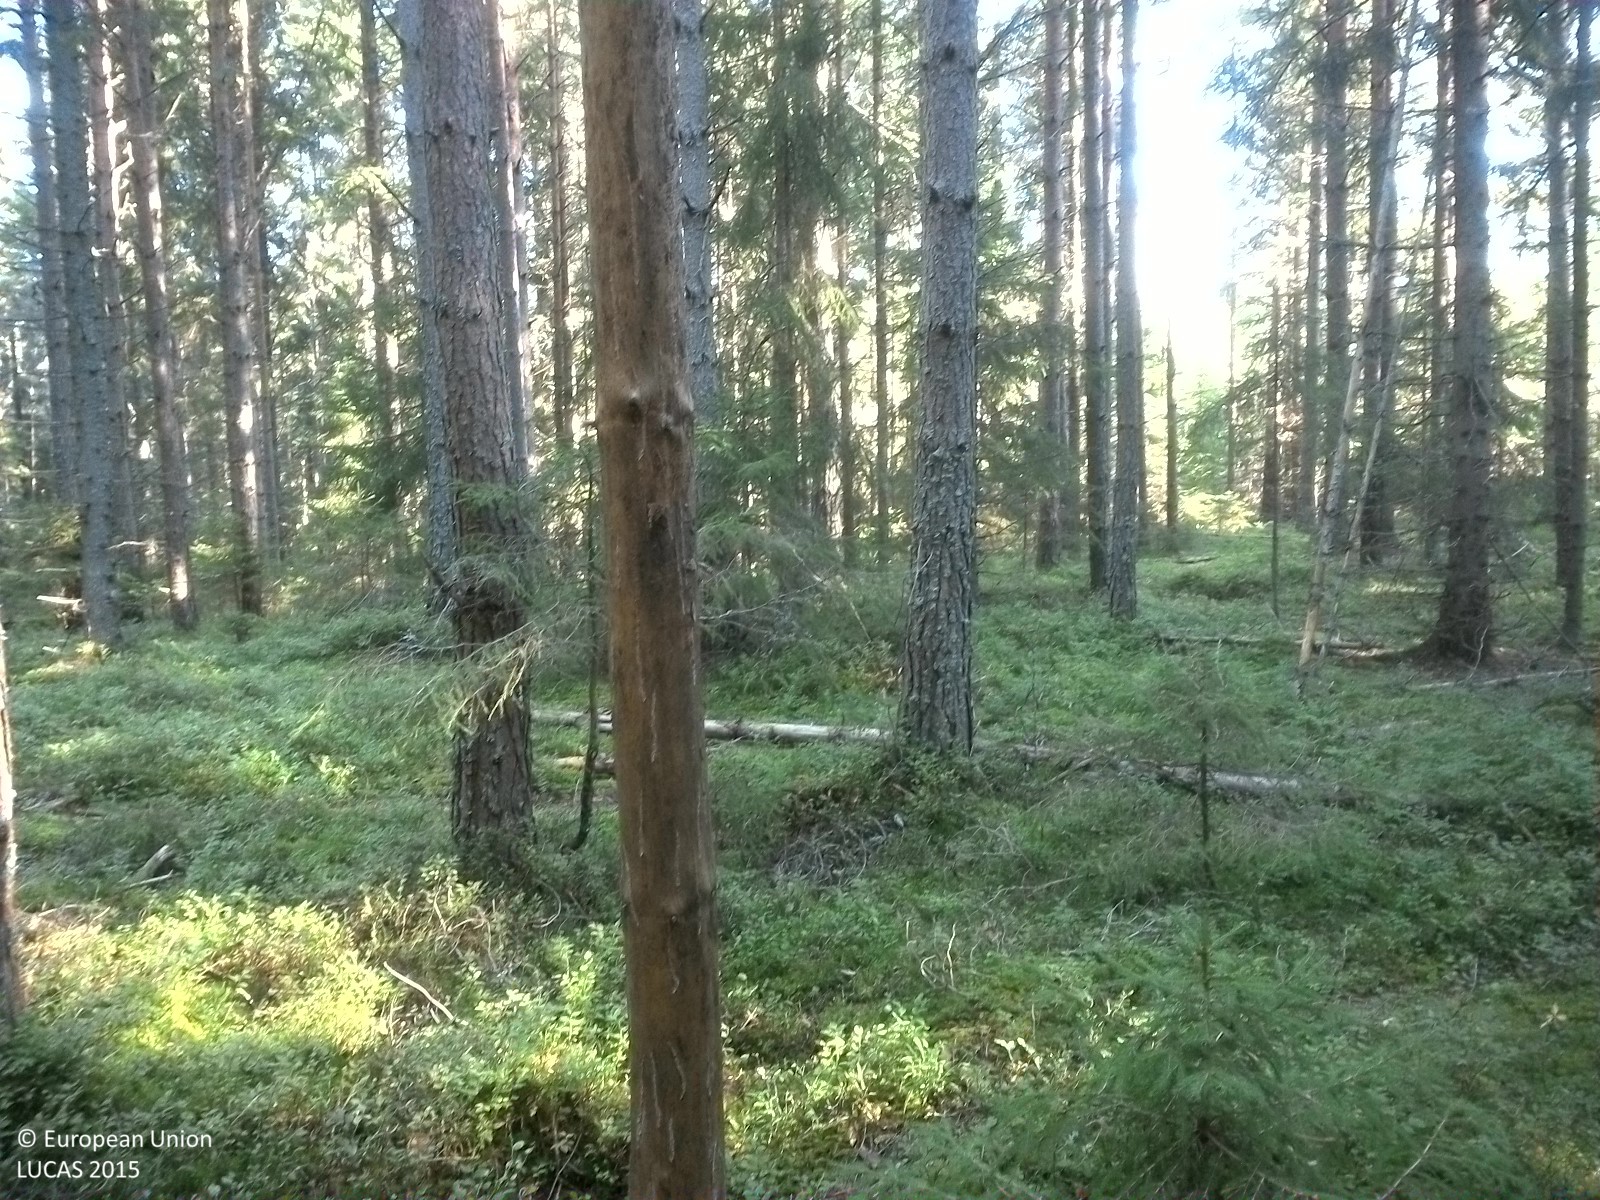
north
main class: Woodland
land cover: Other coniferous woodland
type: boreal forest
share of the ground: 25 - 50 %
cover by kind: coniferous forest trees 45 %, herbaceous plants 35 %, lichens and mosses 20 %
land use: Forestry
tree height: > 5 m
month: September
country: SE
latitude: 59.1030
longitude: 15.8417
